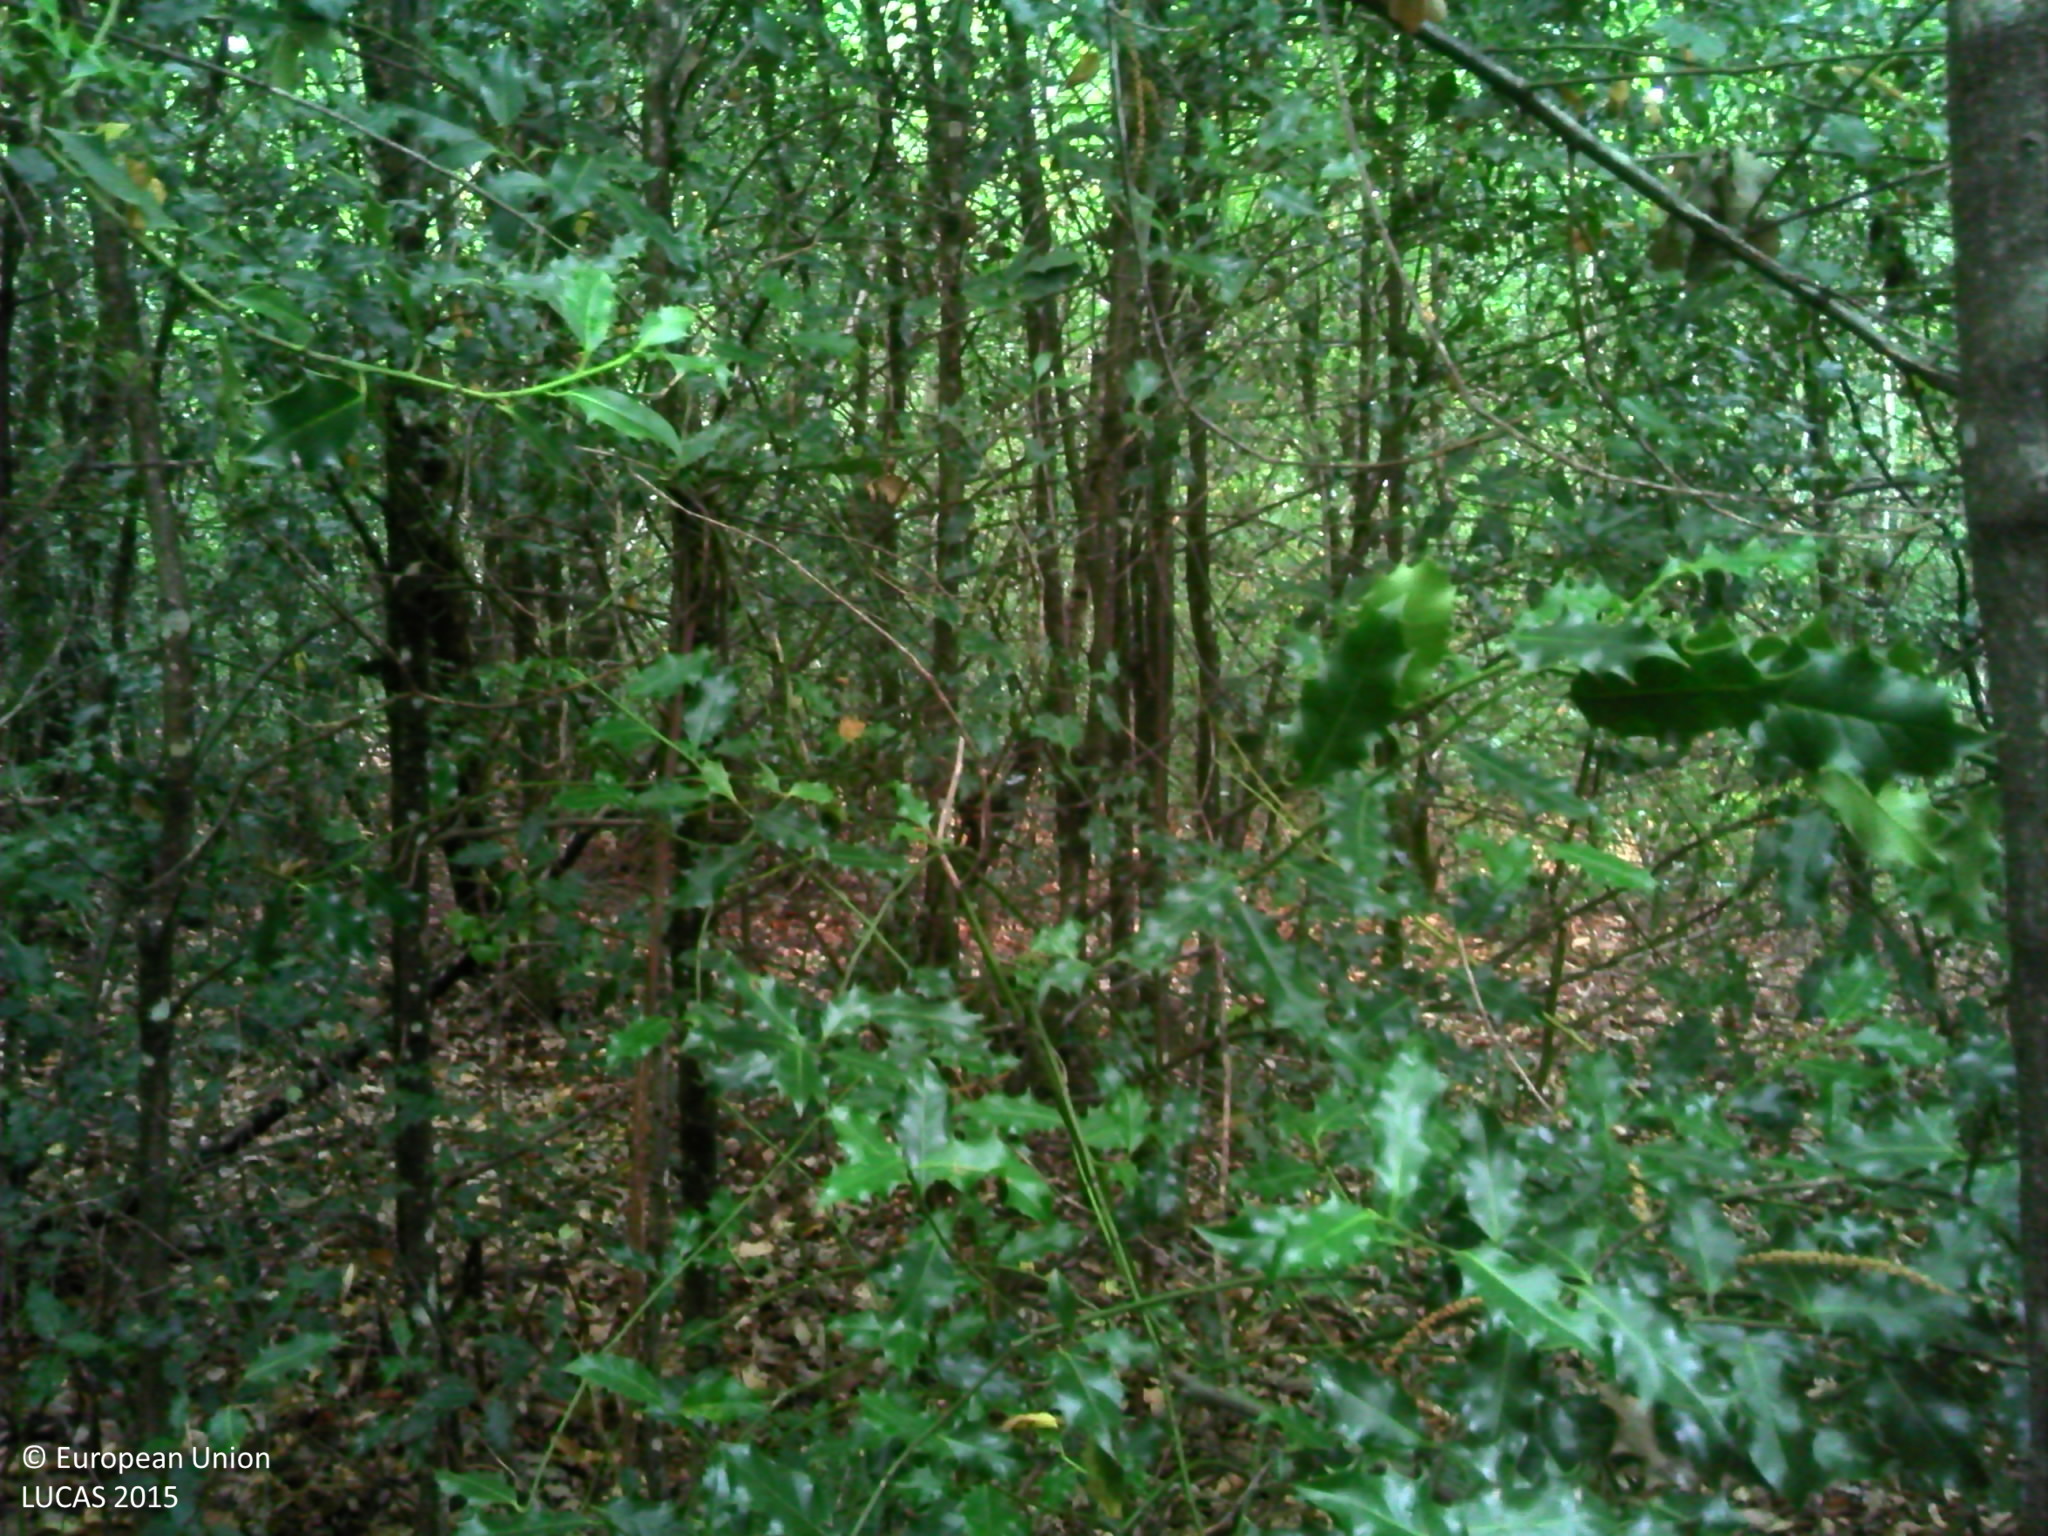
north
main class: Woodland
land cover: Broadleaved woodland
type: boreal forest
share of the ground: > 75 %
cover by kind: broadleaved forest trees 60 %, unconsolidated bare surface 30 %, herbaceous plants 10 %
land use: Forestry
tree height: > 5 m
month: July
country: FR
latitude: 45.6971
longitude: 1.6331
